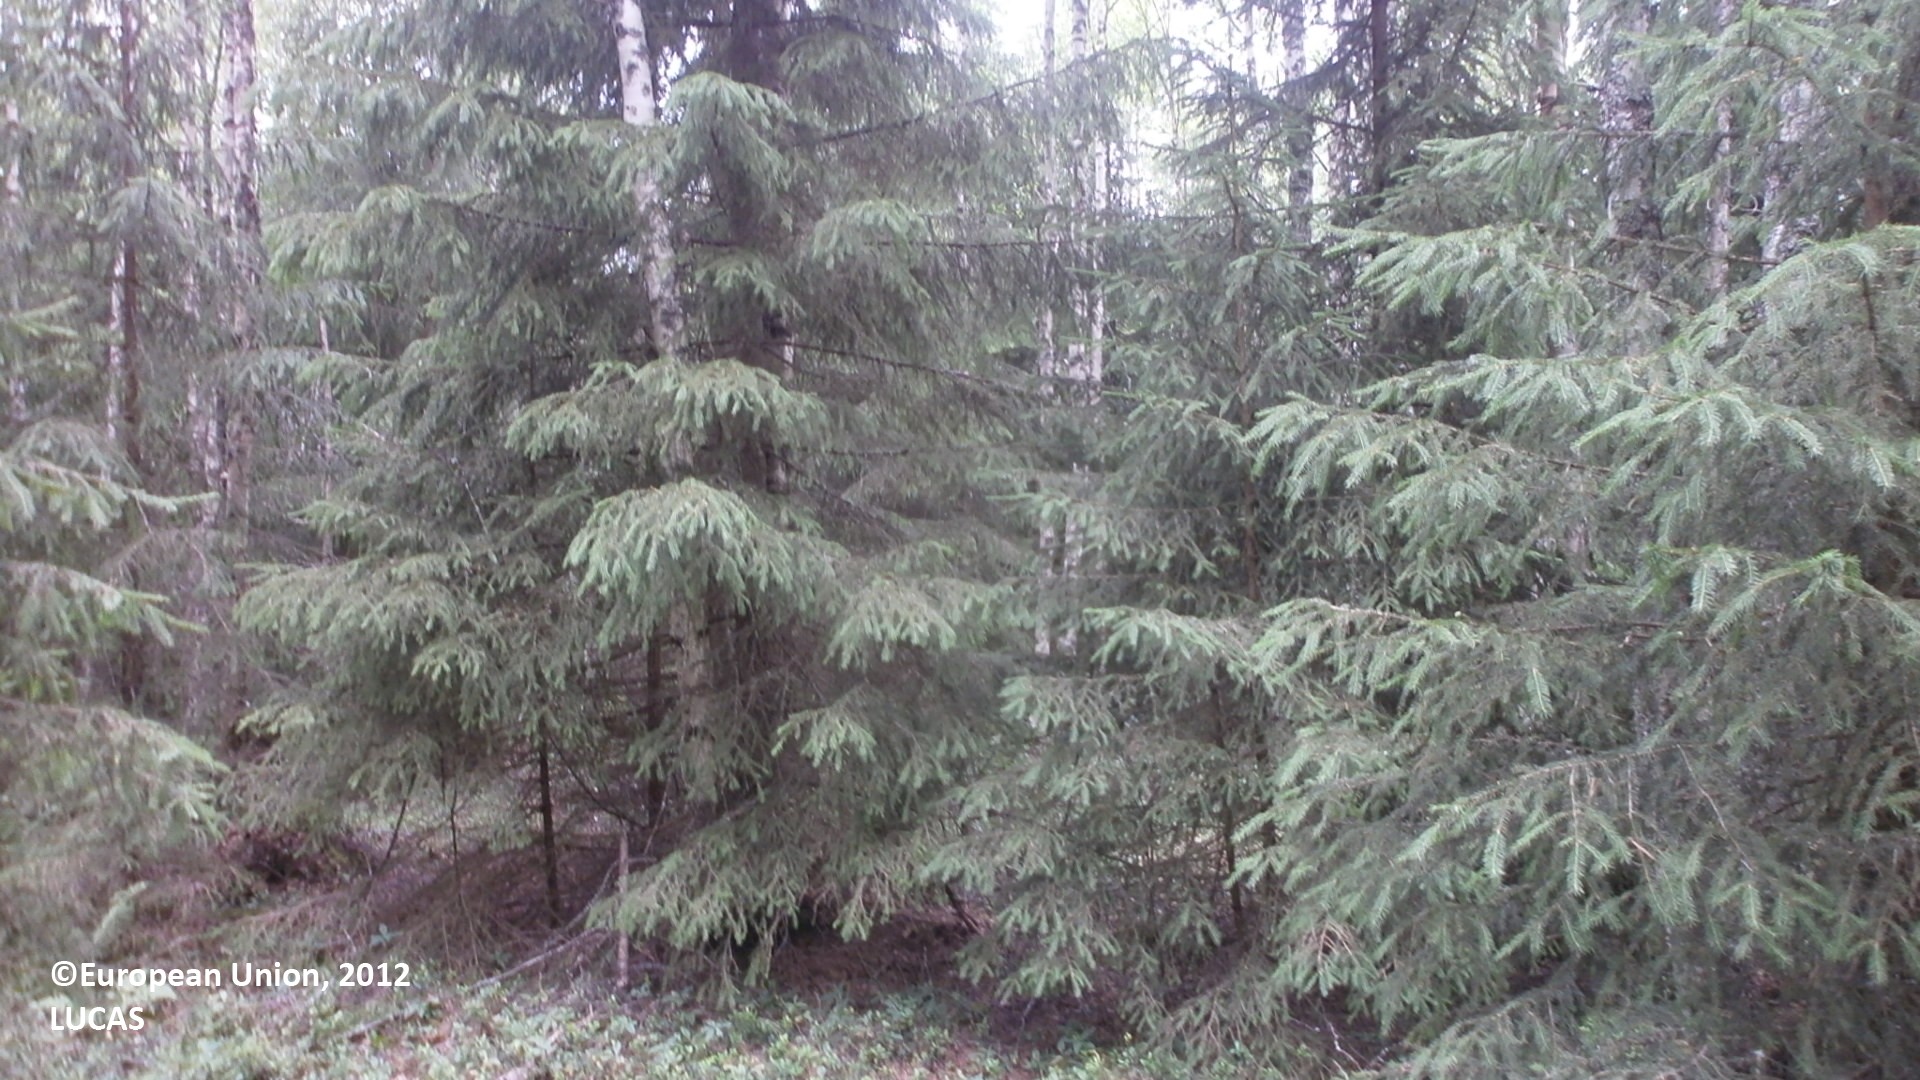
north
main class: Woodland
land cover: Spruce dominated mixed woodland
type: boreal forest
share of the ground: > 75 %
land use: Forestry
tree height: > 5 m
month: July
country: FI
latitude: 64.2210
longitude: 24.1413
